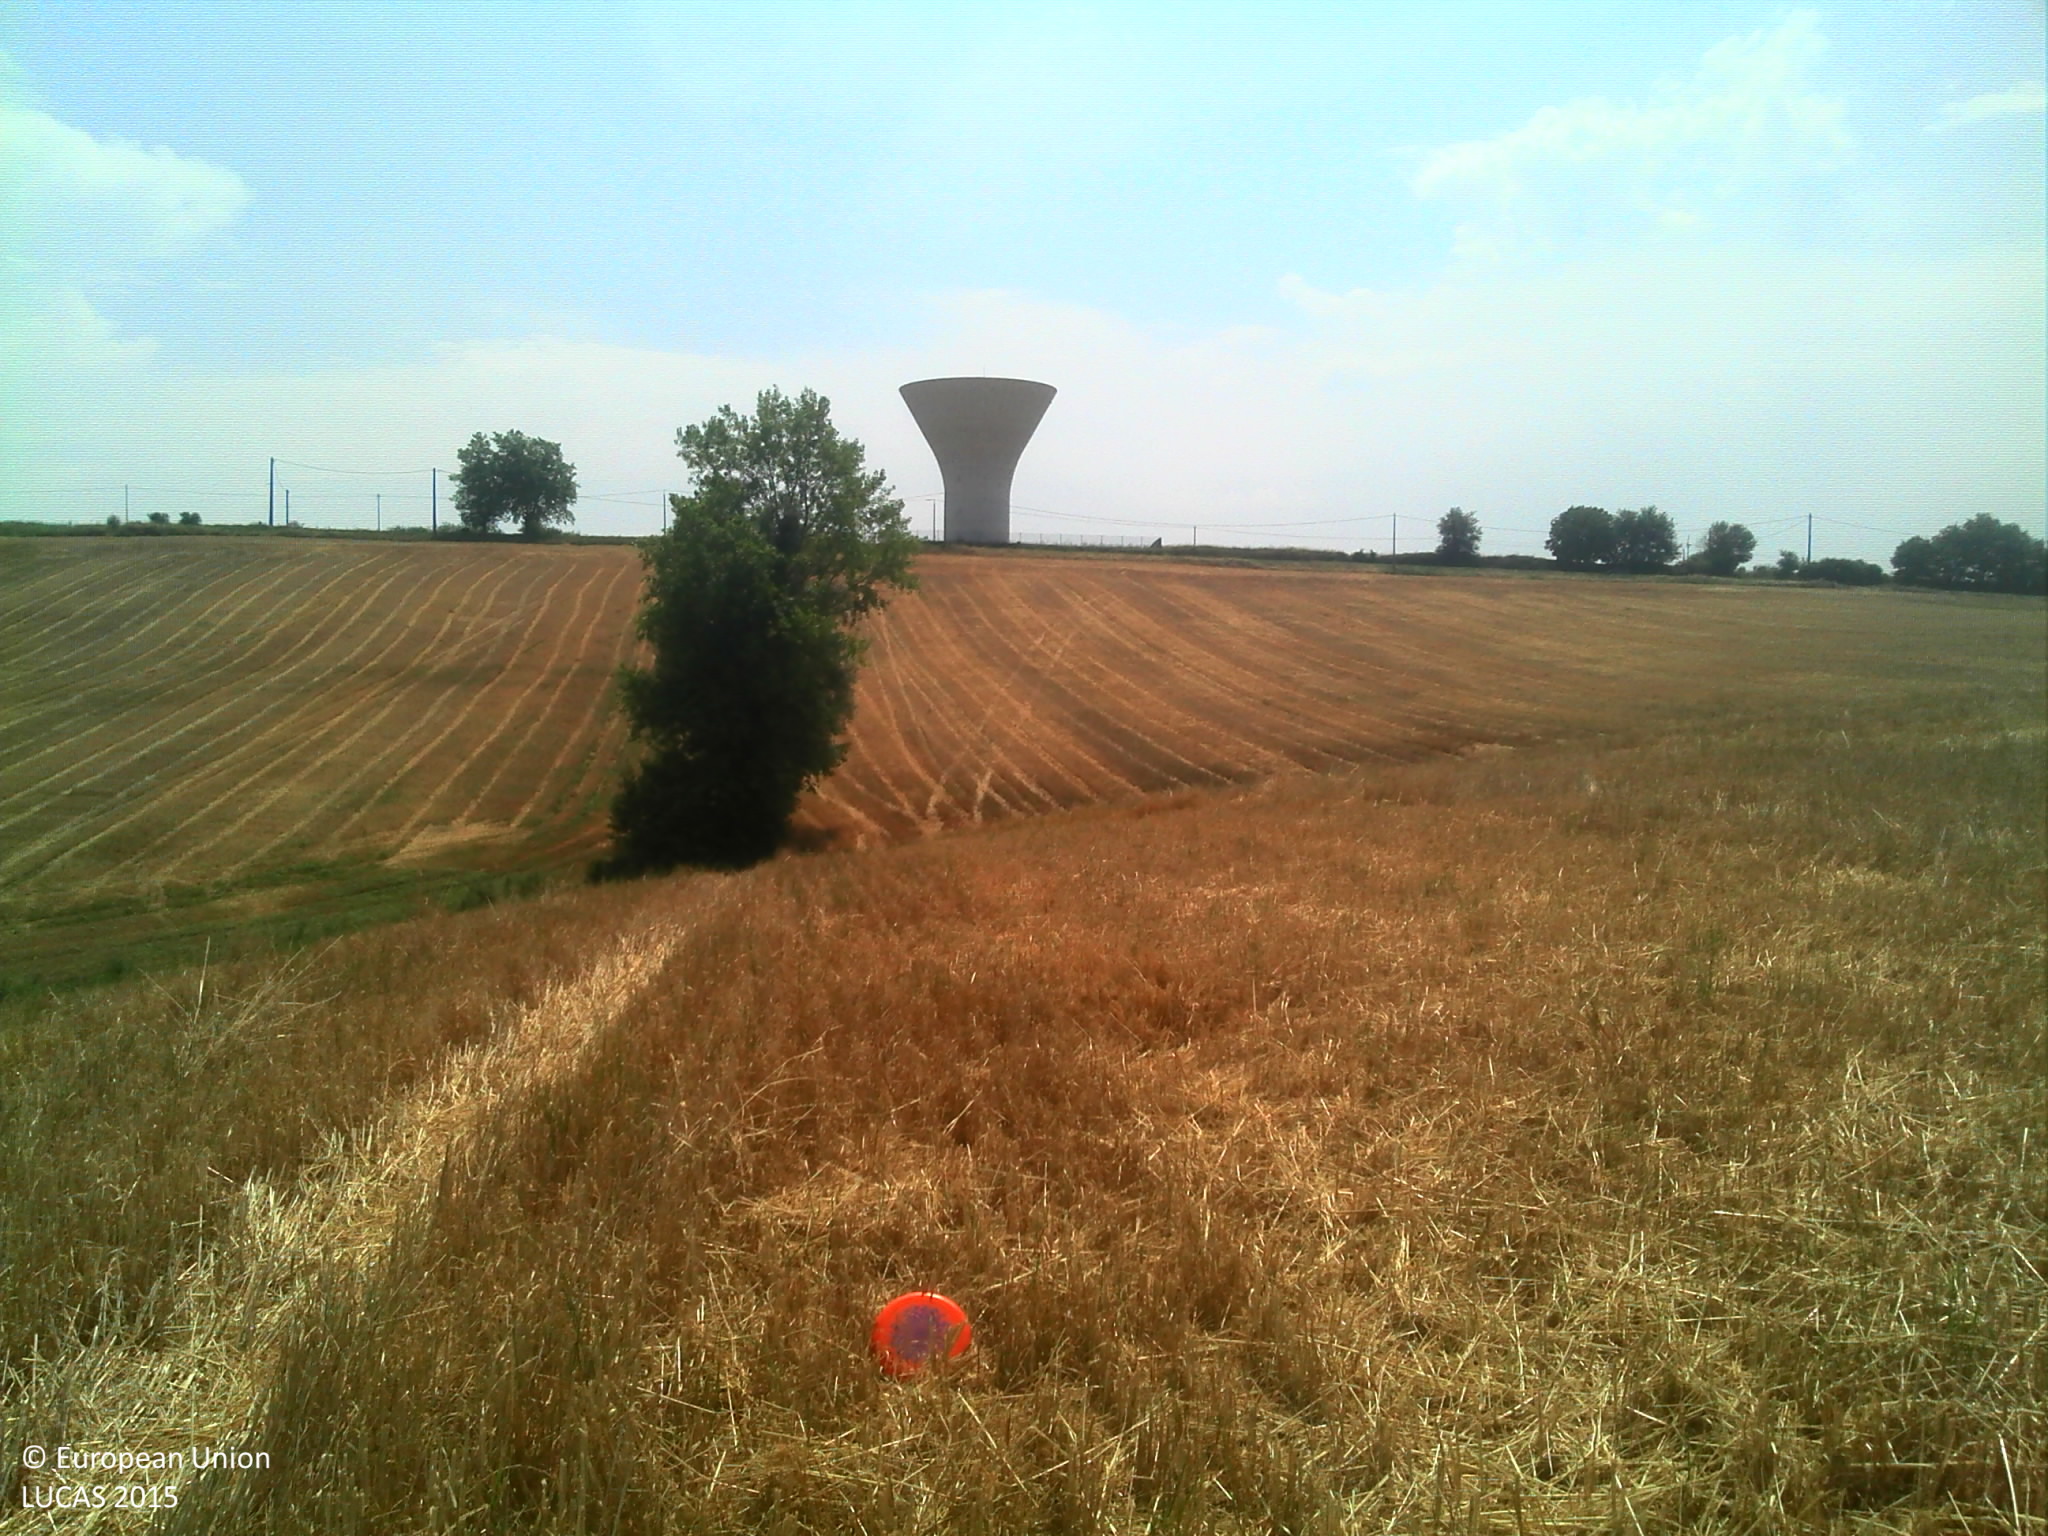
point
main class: Cropland
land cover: Triticale
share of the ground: > 75 %
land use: Agriculture (excluding fallow land and kitchen gardens)
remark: Harvested field
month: July
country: FR
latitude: 43.3032
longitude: 1.6099
